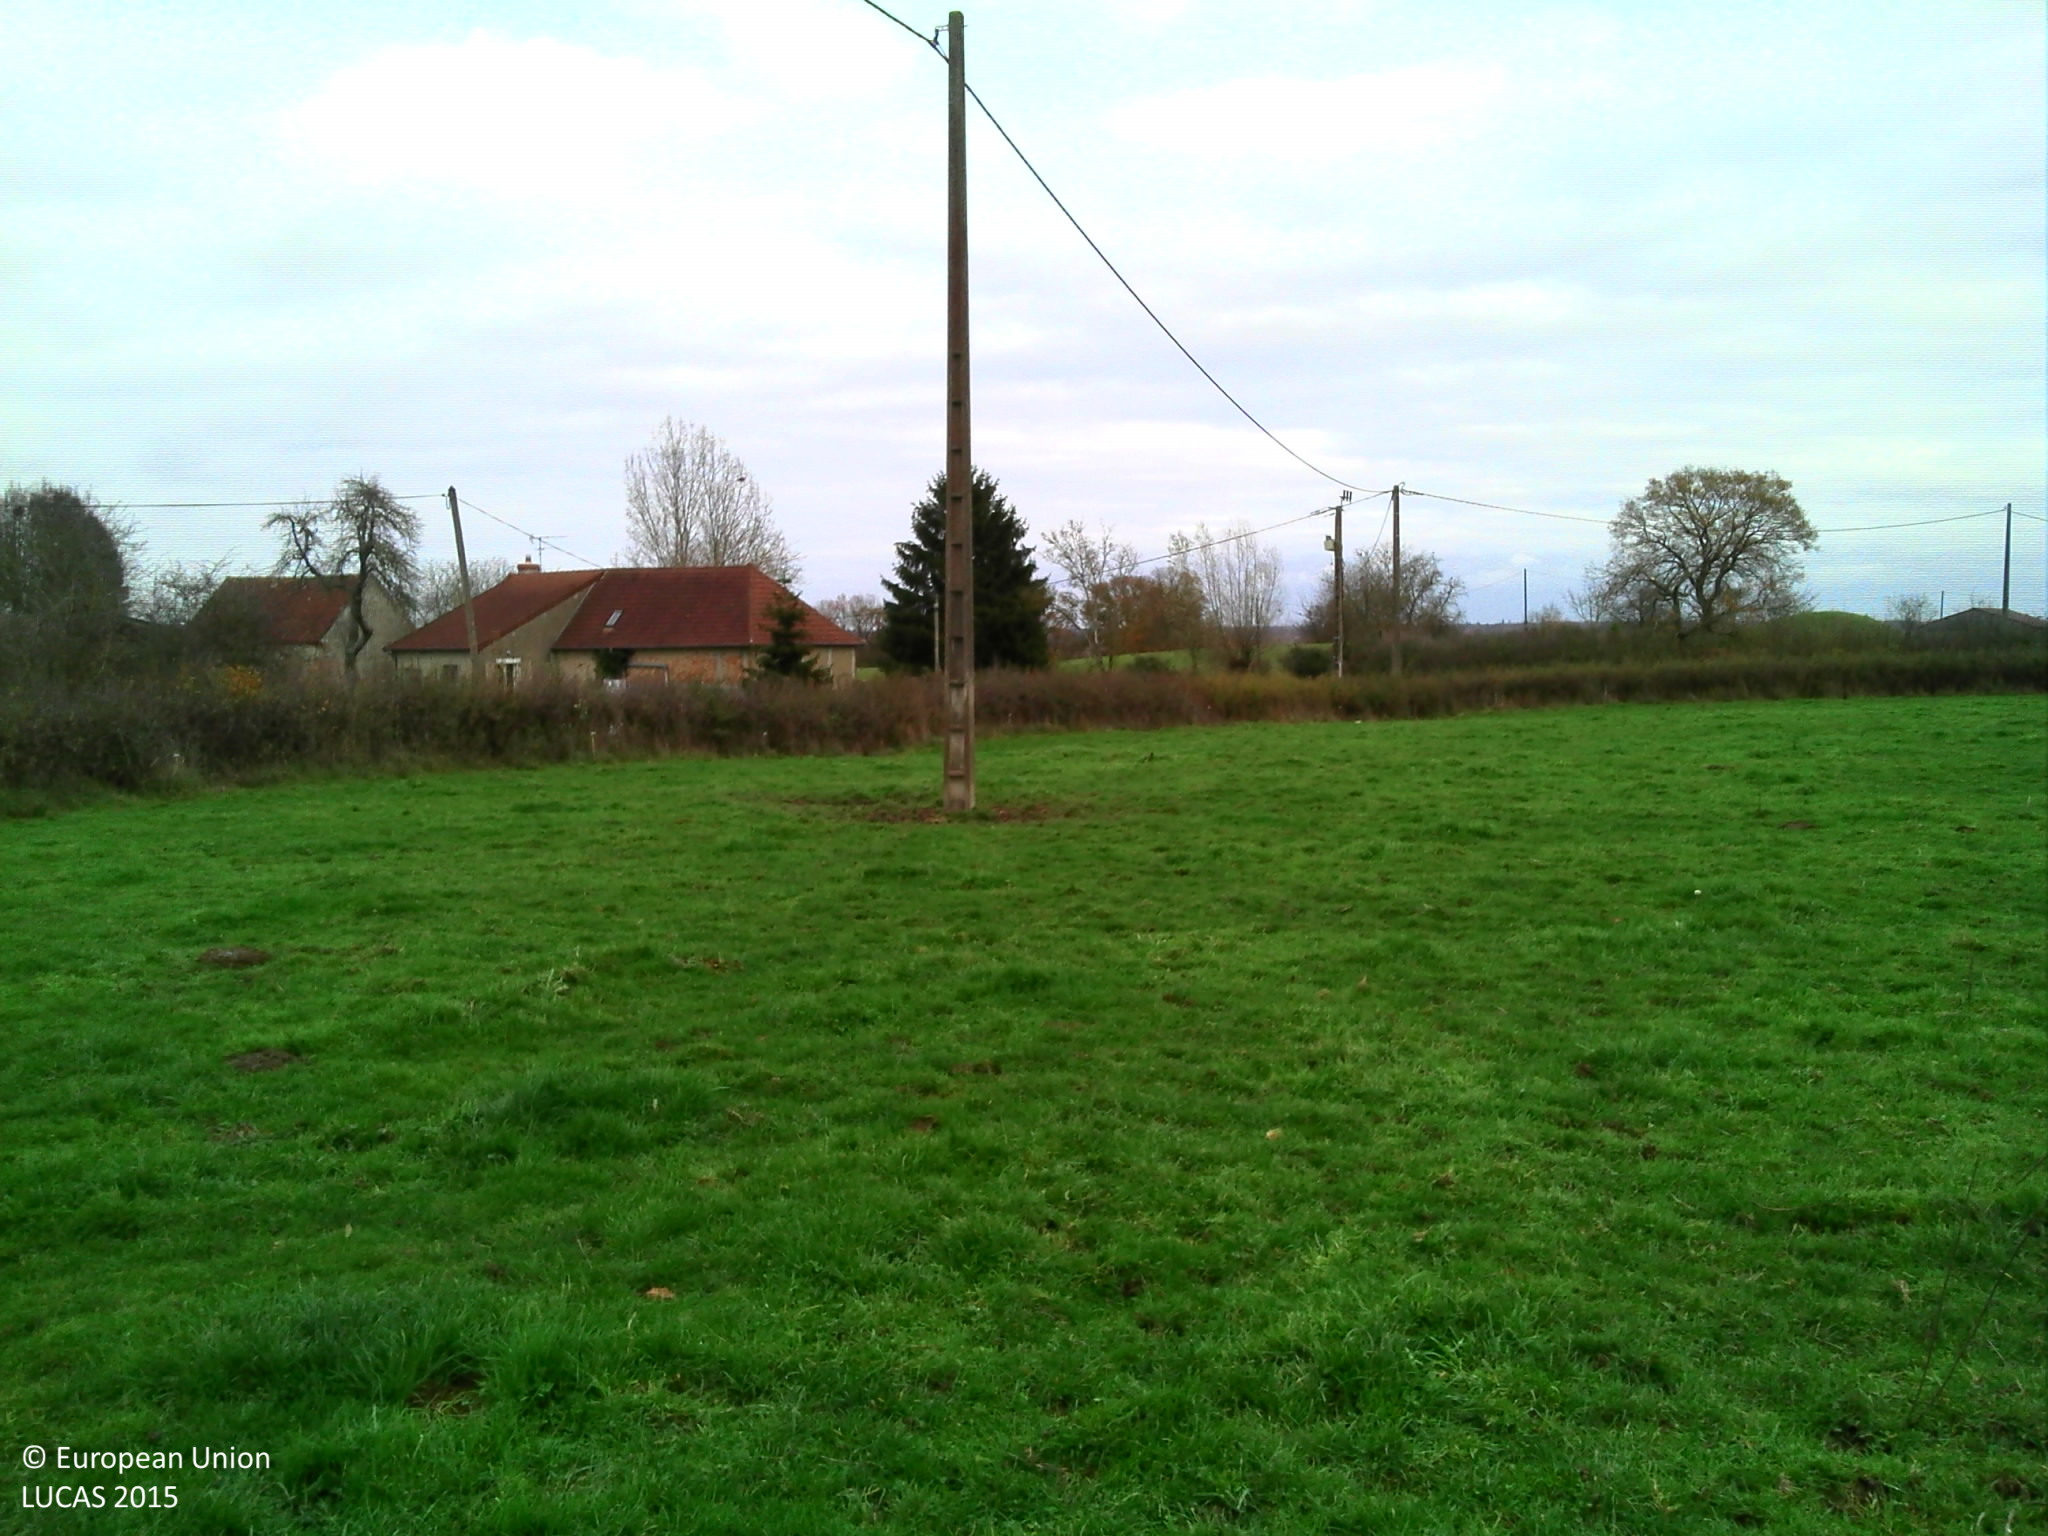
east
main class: Grassland
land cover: Grassland without tree/shrub cover
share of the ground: > 75 %
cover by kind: herbaceous plants 100 %
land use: Agriculture (excluding fallow land and kitchen gardens)
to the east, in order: Grassland without tree/shrub cover; Electric lines; Grassland without tree/shrub cover; Fences; Managed hedges; Electric lines; Grassland without tree/shrub cover; Managed hedges; Fences; Grassland without tree/shrub cover; Fences; Managed hedges; Grass margins; Paved roads, cycling and walking lanes; Grass margins; Fences; Electric lines; Shrubland with sparse tree cover; Grassland with sparse tree/shrub cover; Broadleaved woodland; Fences; Grassland without tree/shrub cover
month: November
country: FR
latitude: 46.6418
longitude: 3.2172
